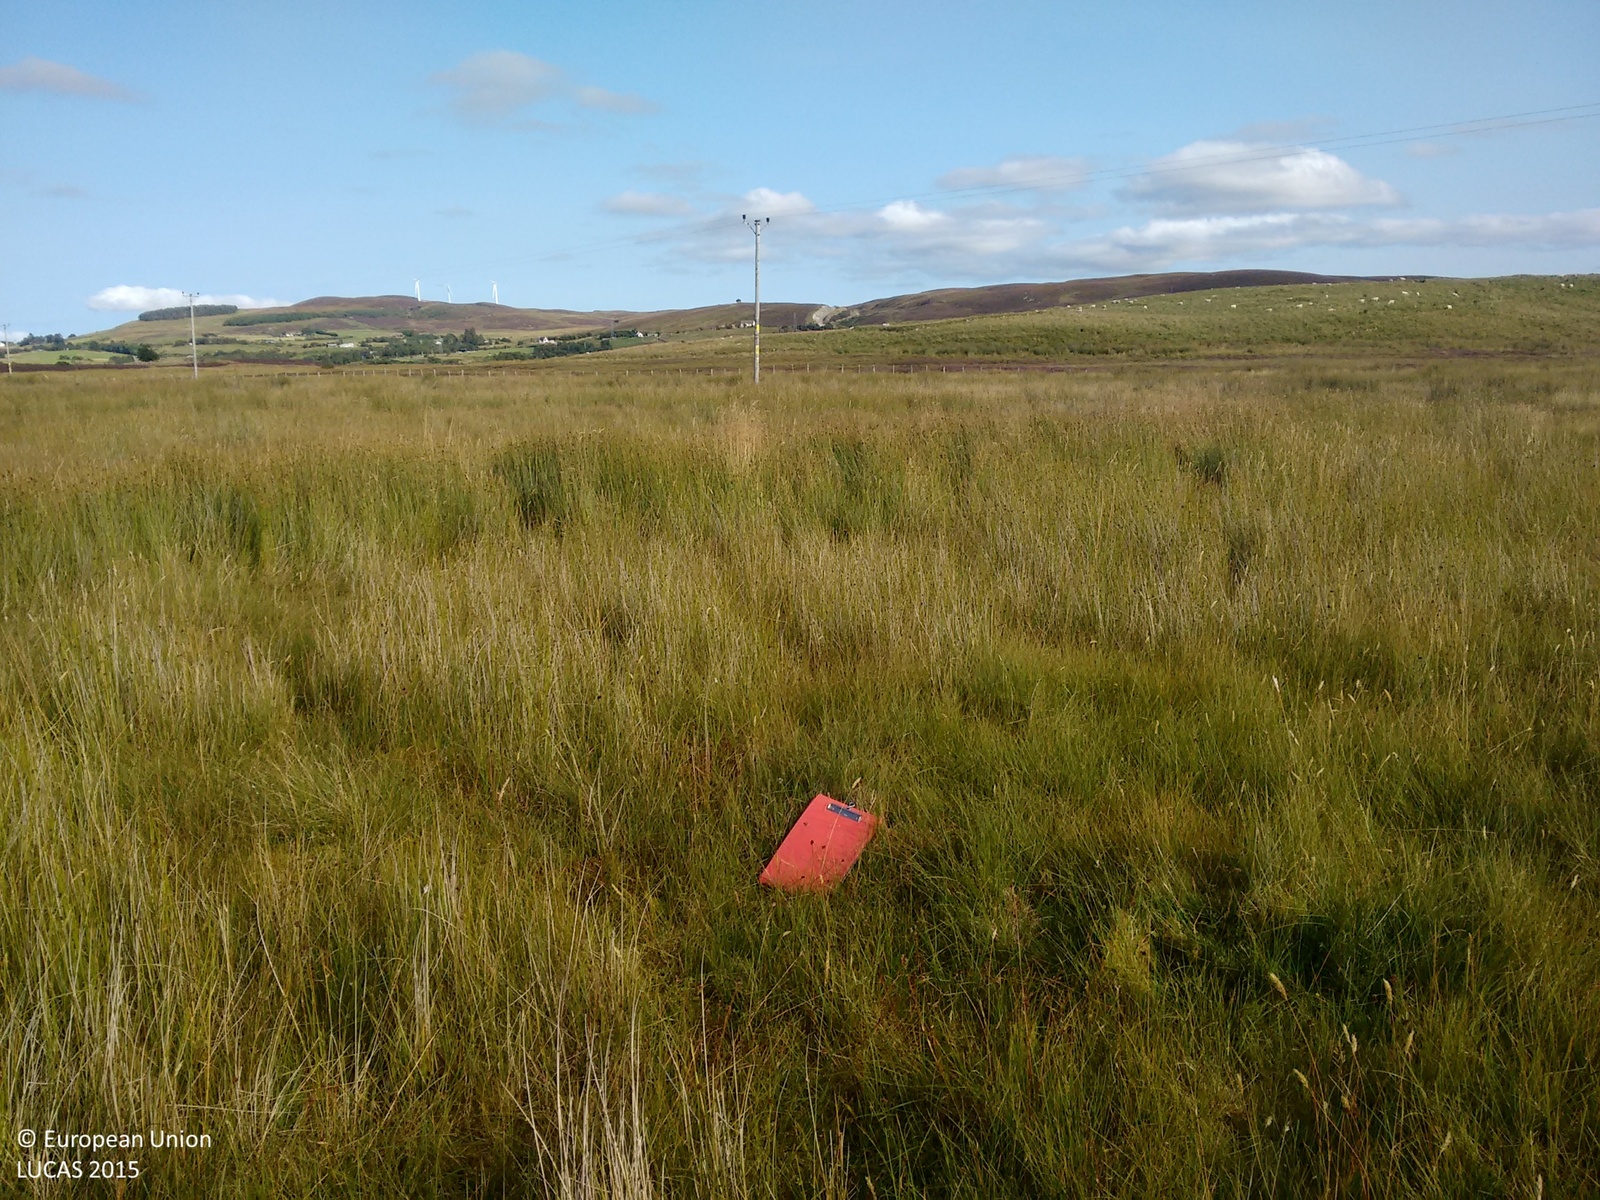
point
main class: Grassland
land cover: Grassland without tree/shrub cover
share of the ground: > 75 %
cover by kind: herbaceous plants 70 %, lichens and mosses 30 %
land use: Agriculture (excluding fallow land and kitchen gardens)
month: September
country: GB
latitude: 58.0041
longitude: -4.4186
